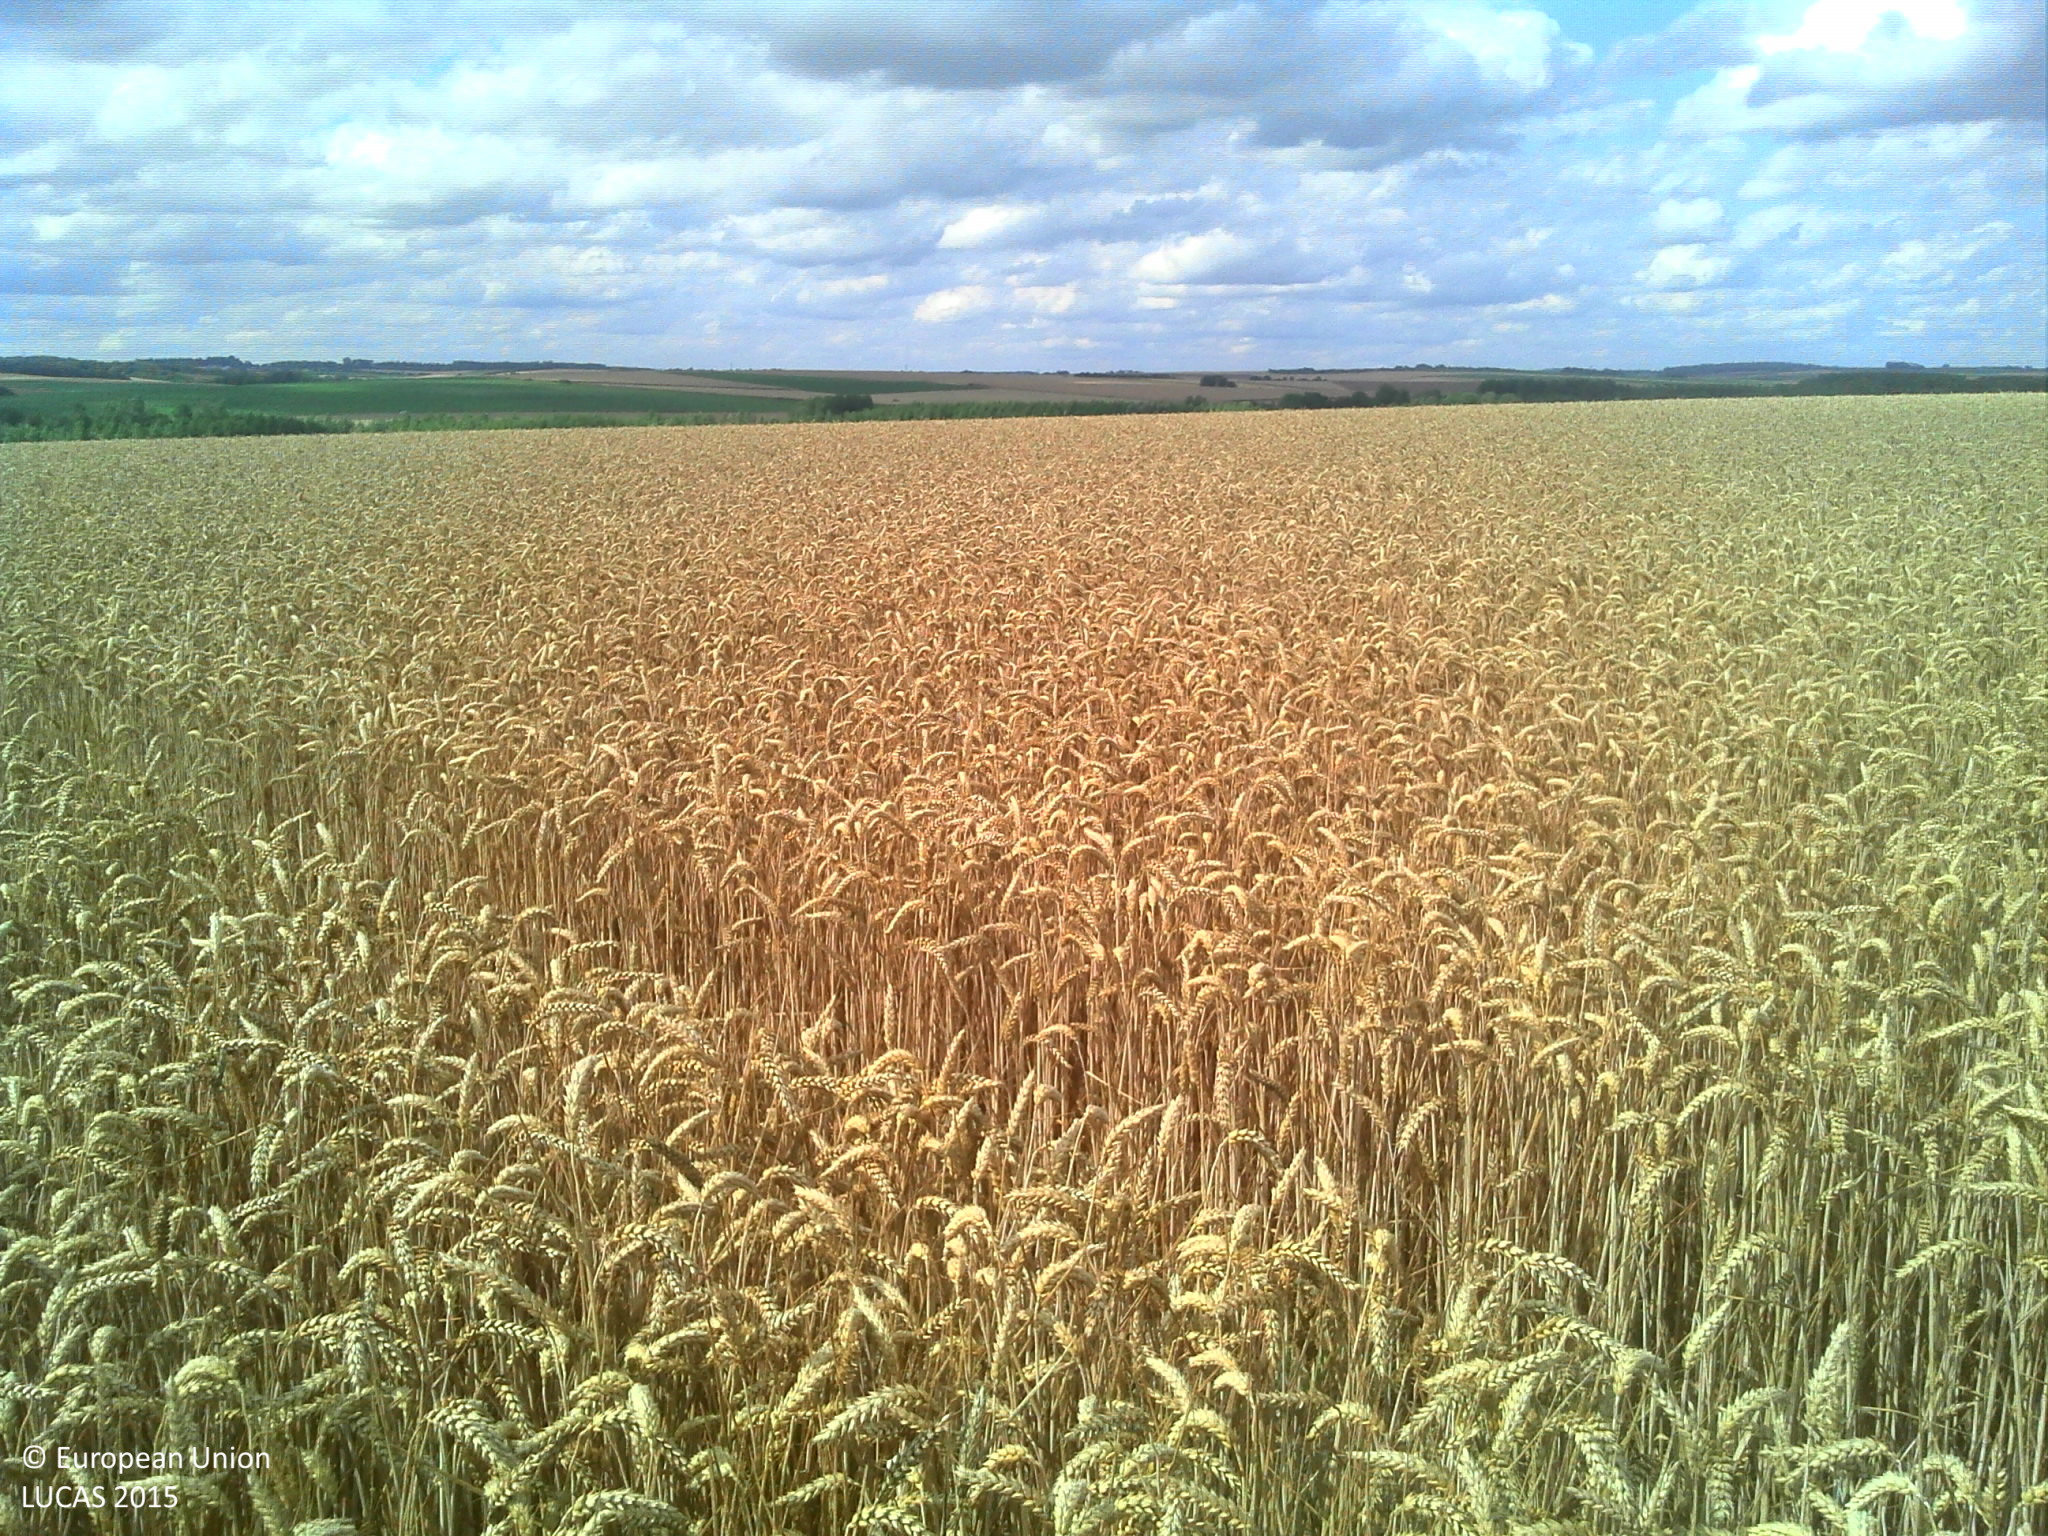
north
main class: Cropland
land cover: Common wheat
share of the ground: > 75 %
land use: Agriculture (excluding fallow land and kitchen gardens)
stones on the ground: < 10 %
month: July
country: FR
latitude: 49.7516
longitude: 3.5946
